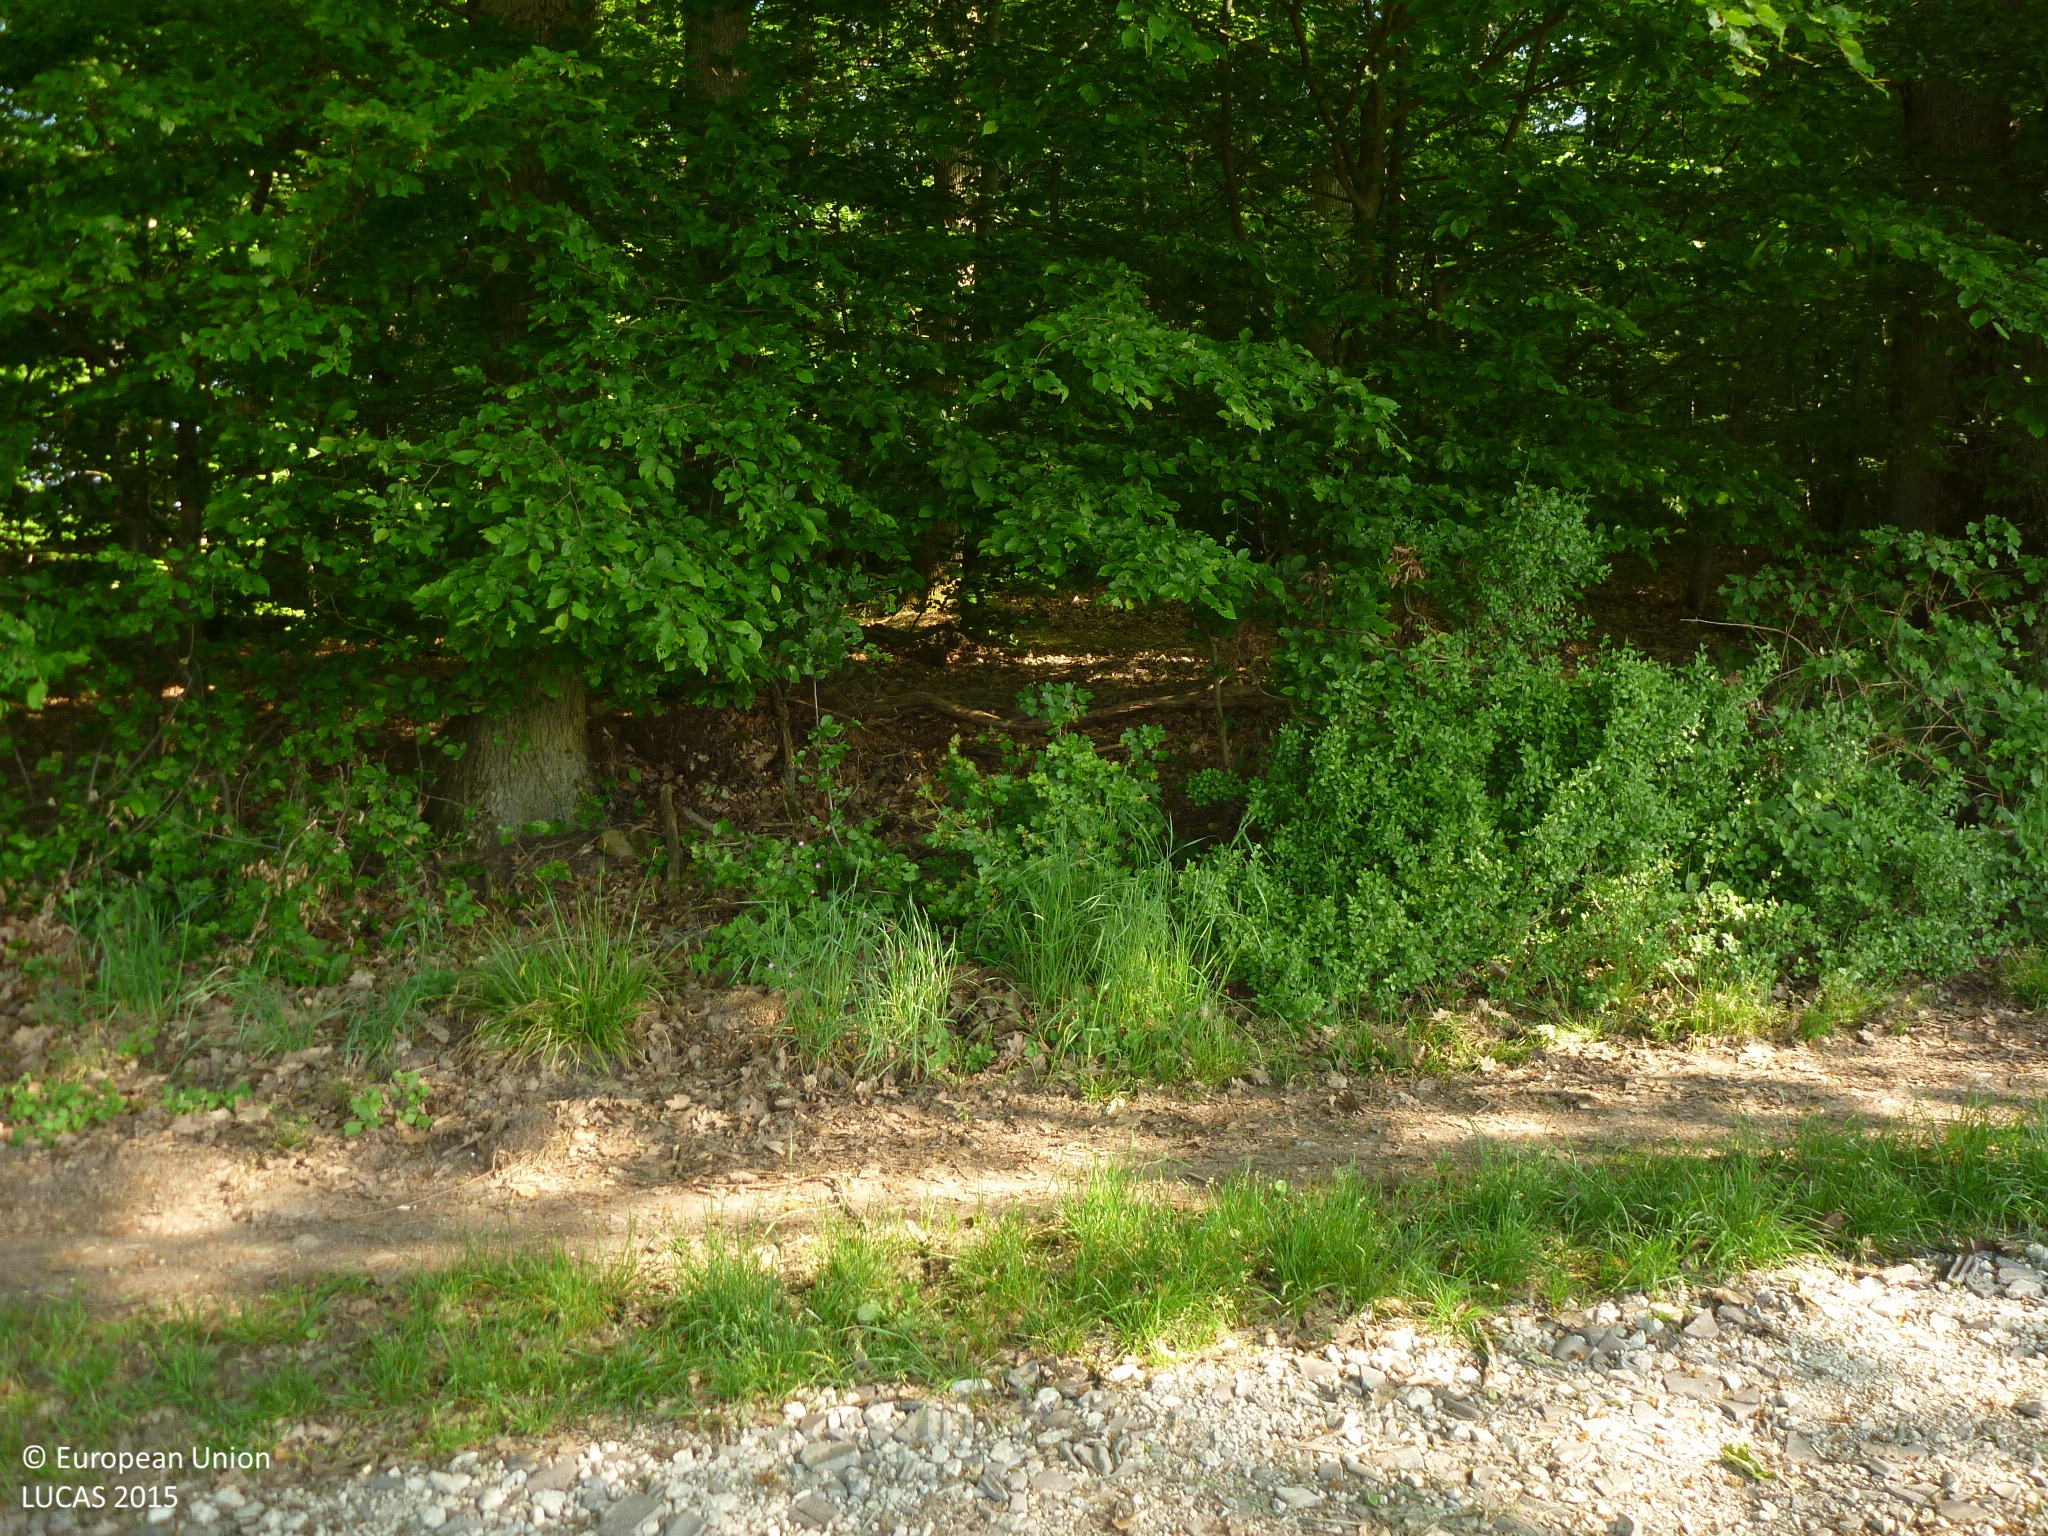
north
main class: Cropland
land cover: Vineyards
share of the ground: 25 - 50 %
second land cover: Grassland without tree/shrub cover
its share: > 75 %
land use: Agriculture (excluding fallow land and kitchen gardens)
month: May
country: DE
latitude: 49.1031
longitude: 9.3291
